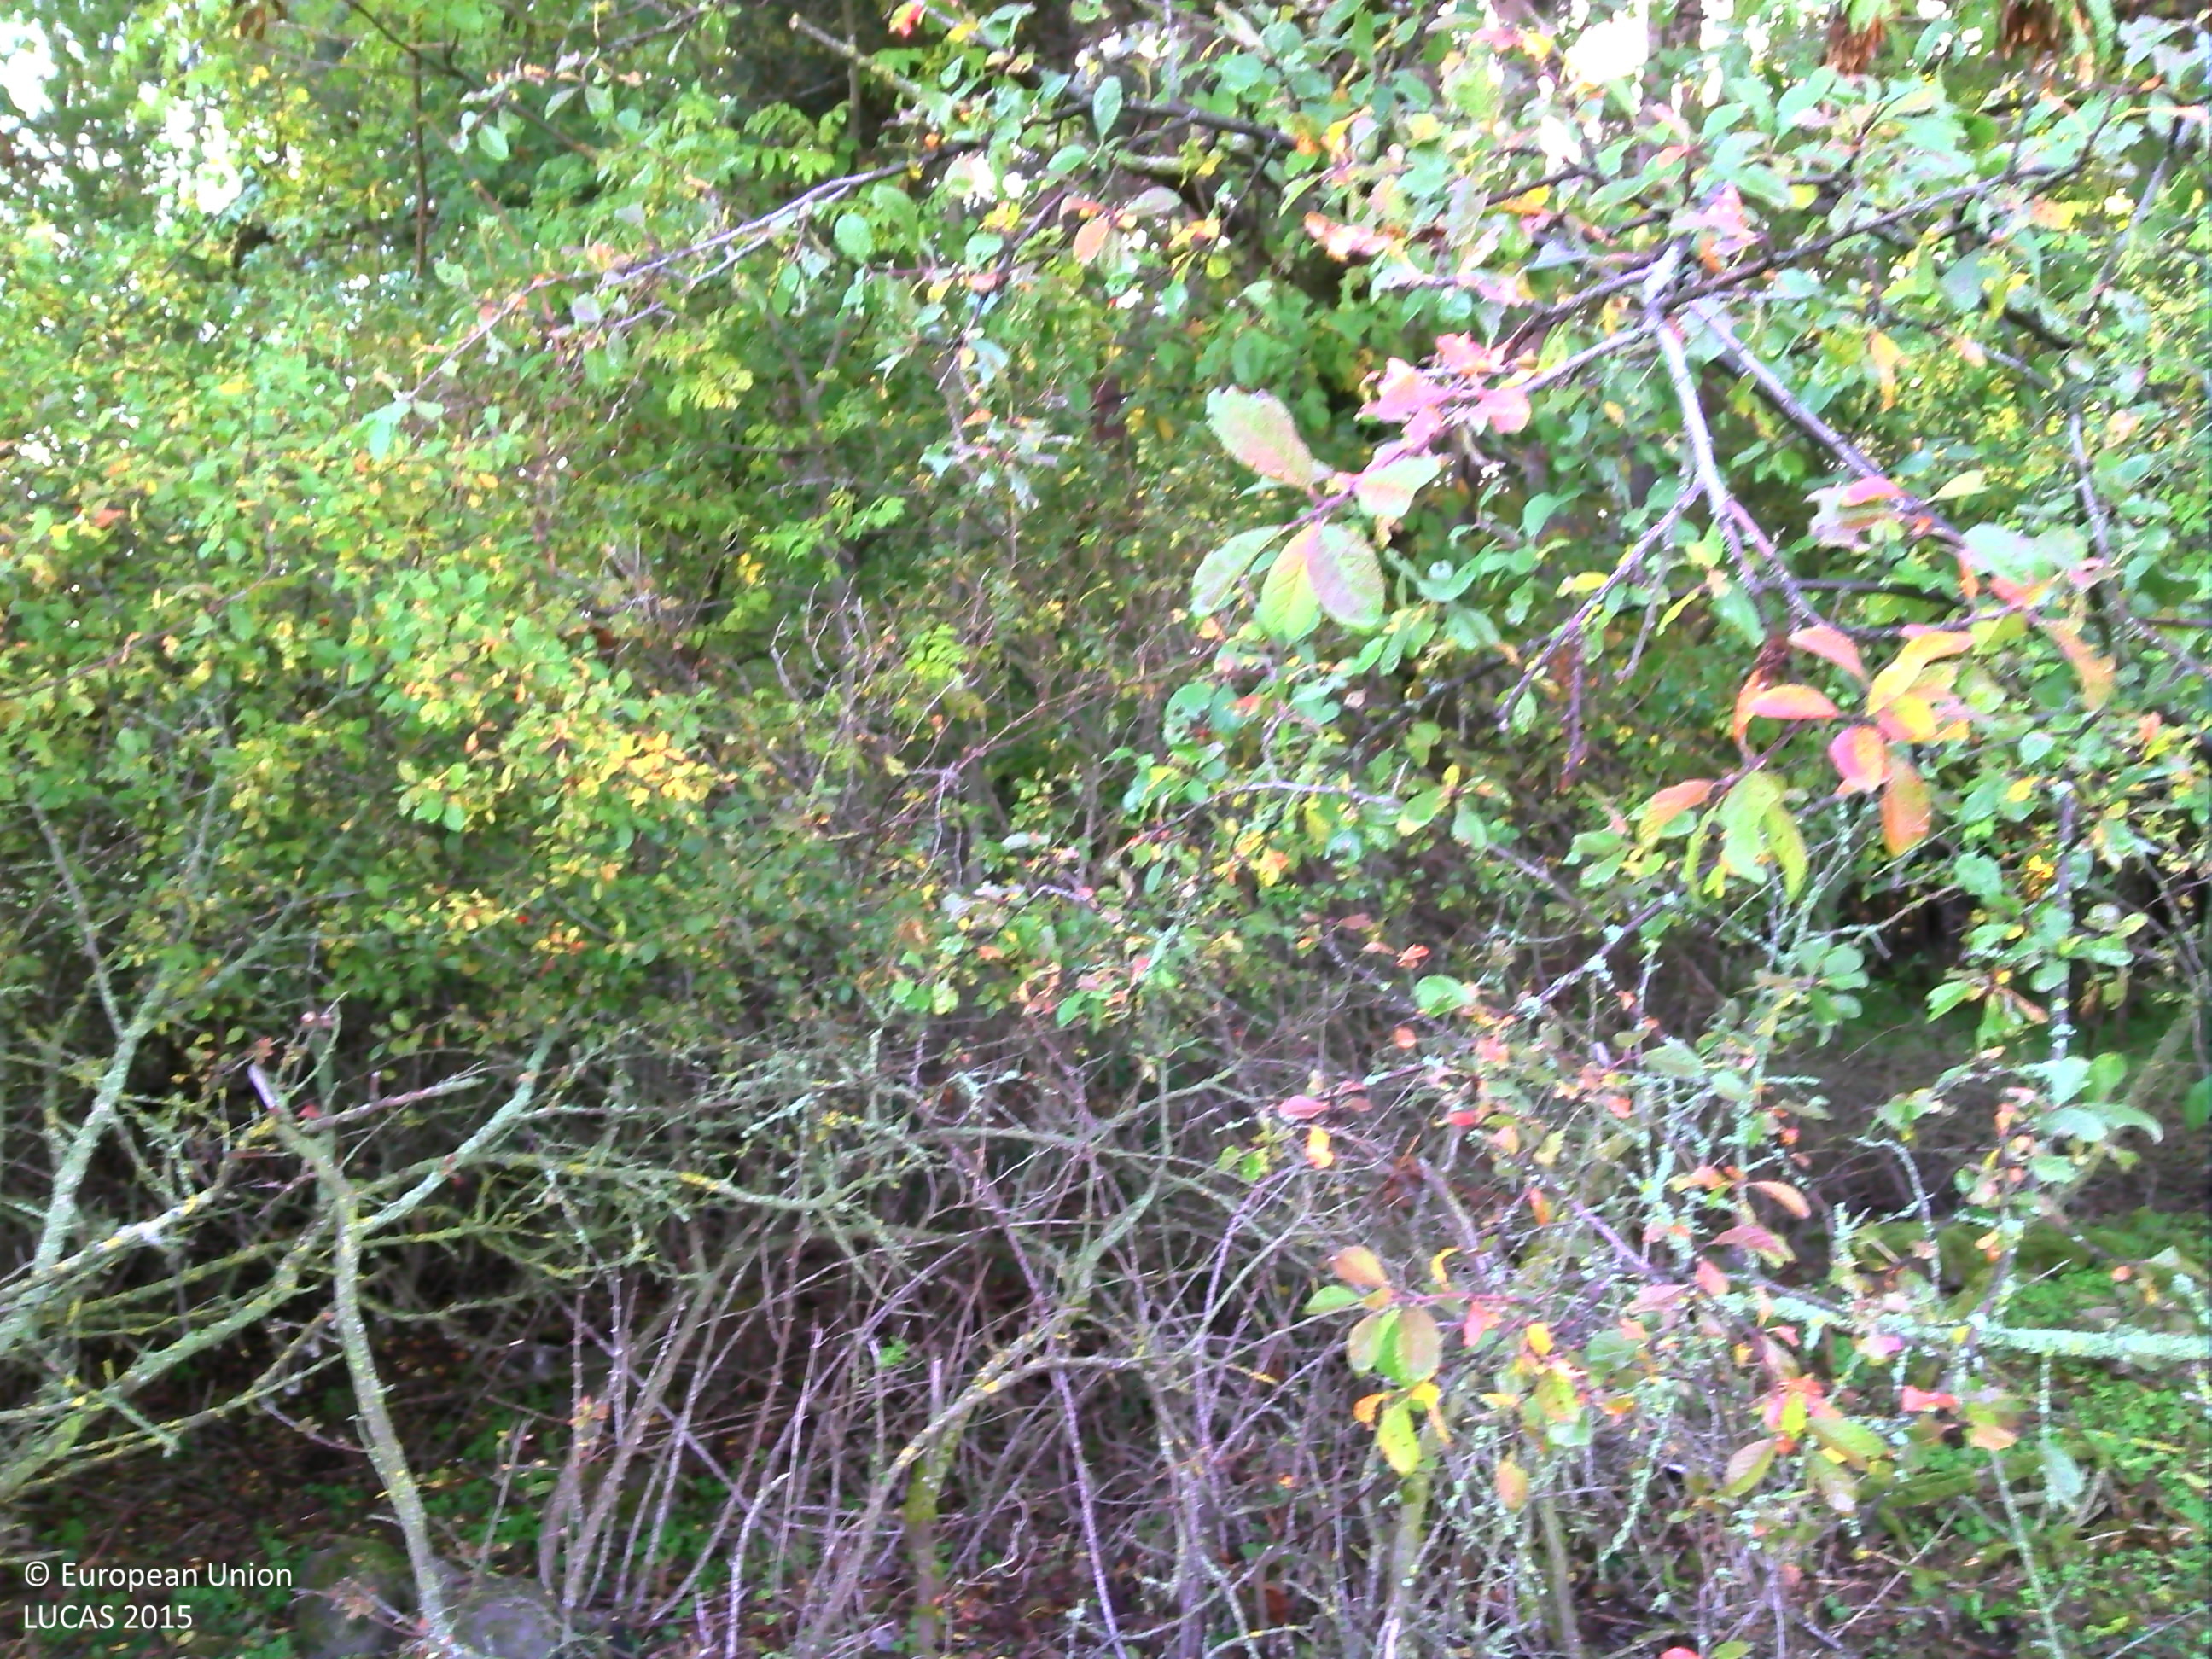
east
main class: Woodland
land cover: Pine dominated mixed woodland
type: acidophilous oak and oak-birch forest
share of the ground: > 75 %
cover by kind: coniferous forest trees 60 %, broadleaved forest trees 20 %, herbaceous plants 20 %
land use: Forestry
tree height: > 5 m
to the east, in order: Fences; Pine dominated mixed woodland; Fences; Spruce dominated mixed woodland; Tracks; Pine dominated mixed woodland; Fences; Pine dominated mixed woodland; Grassland without tree/shrub cover; Abandoned hedges; Fences; Dry stone walls; Grassland without tree/shrub cover; Conifer hedges; Grassland with sparse tree/shrub cover
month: July
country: FR
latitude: 45.0882
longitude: 3.8164
